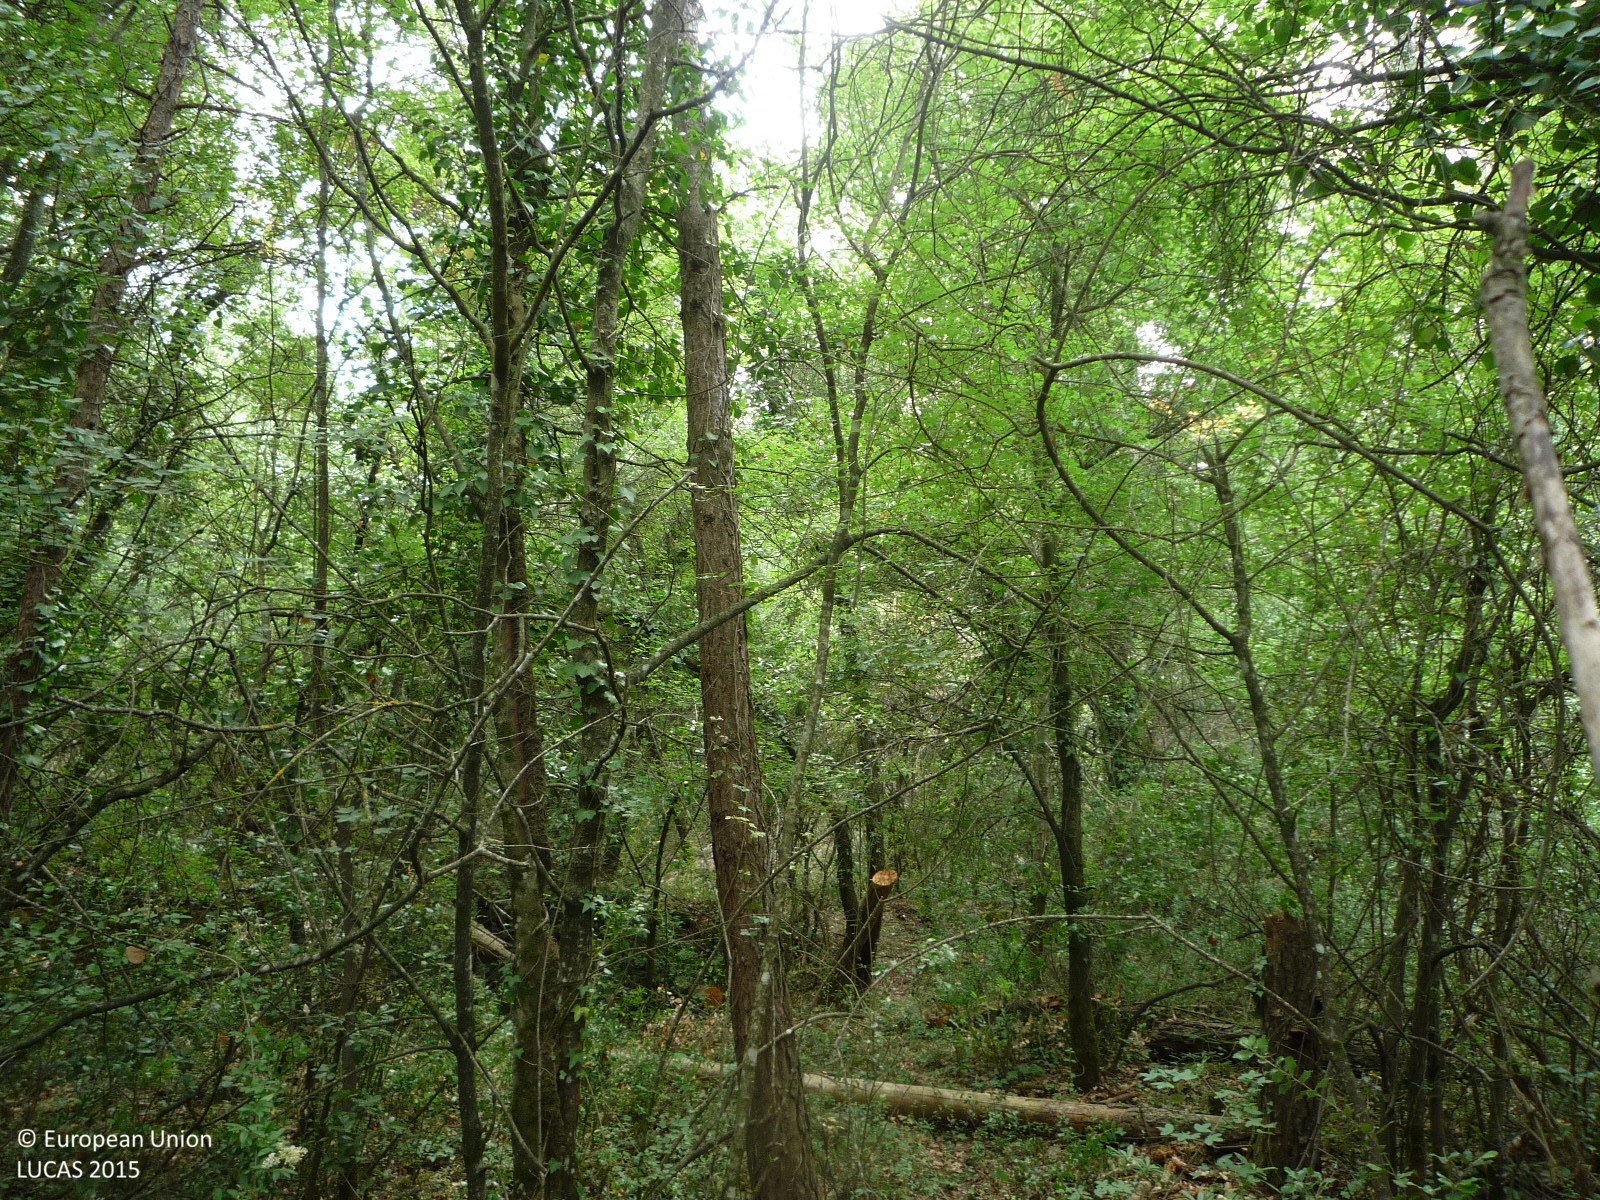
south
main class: Woodland
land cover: Pine dominated mixed woodland
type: coniferous forest of the mediterranean region
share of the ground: > 75 %
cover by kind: coniferous forest trees 60 %, broadleaved forest trees 40 %
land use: Forestry
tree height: > 5 m
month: June
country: ES
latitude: 41.8118
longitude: 2.0102
